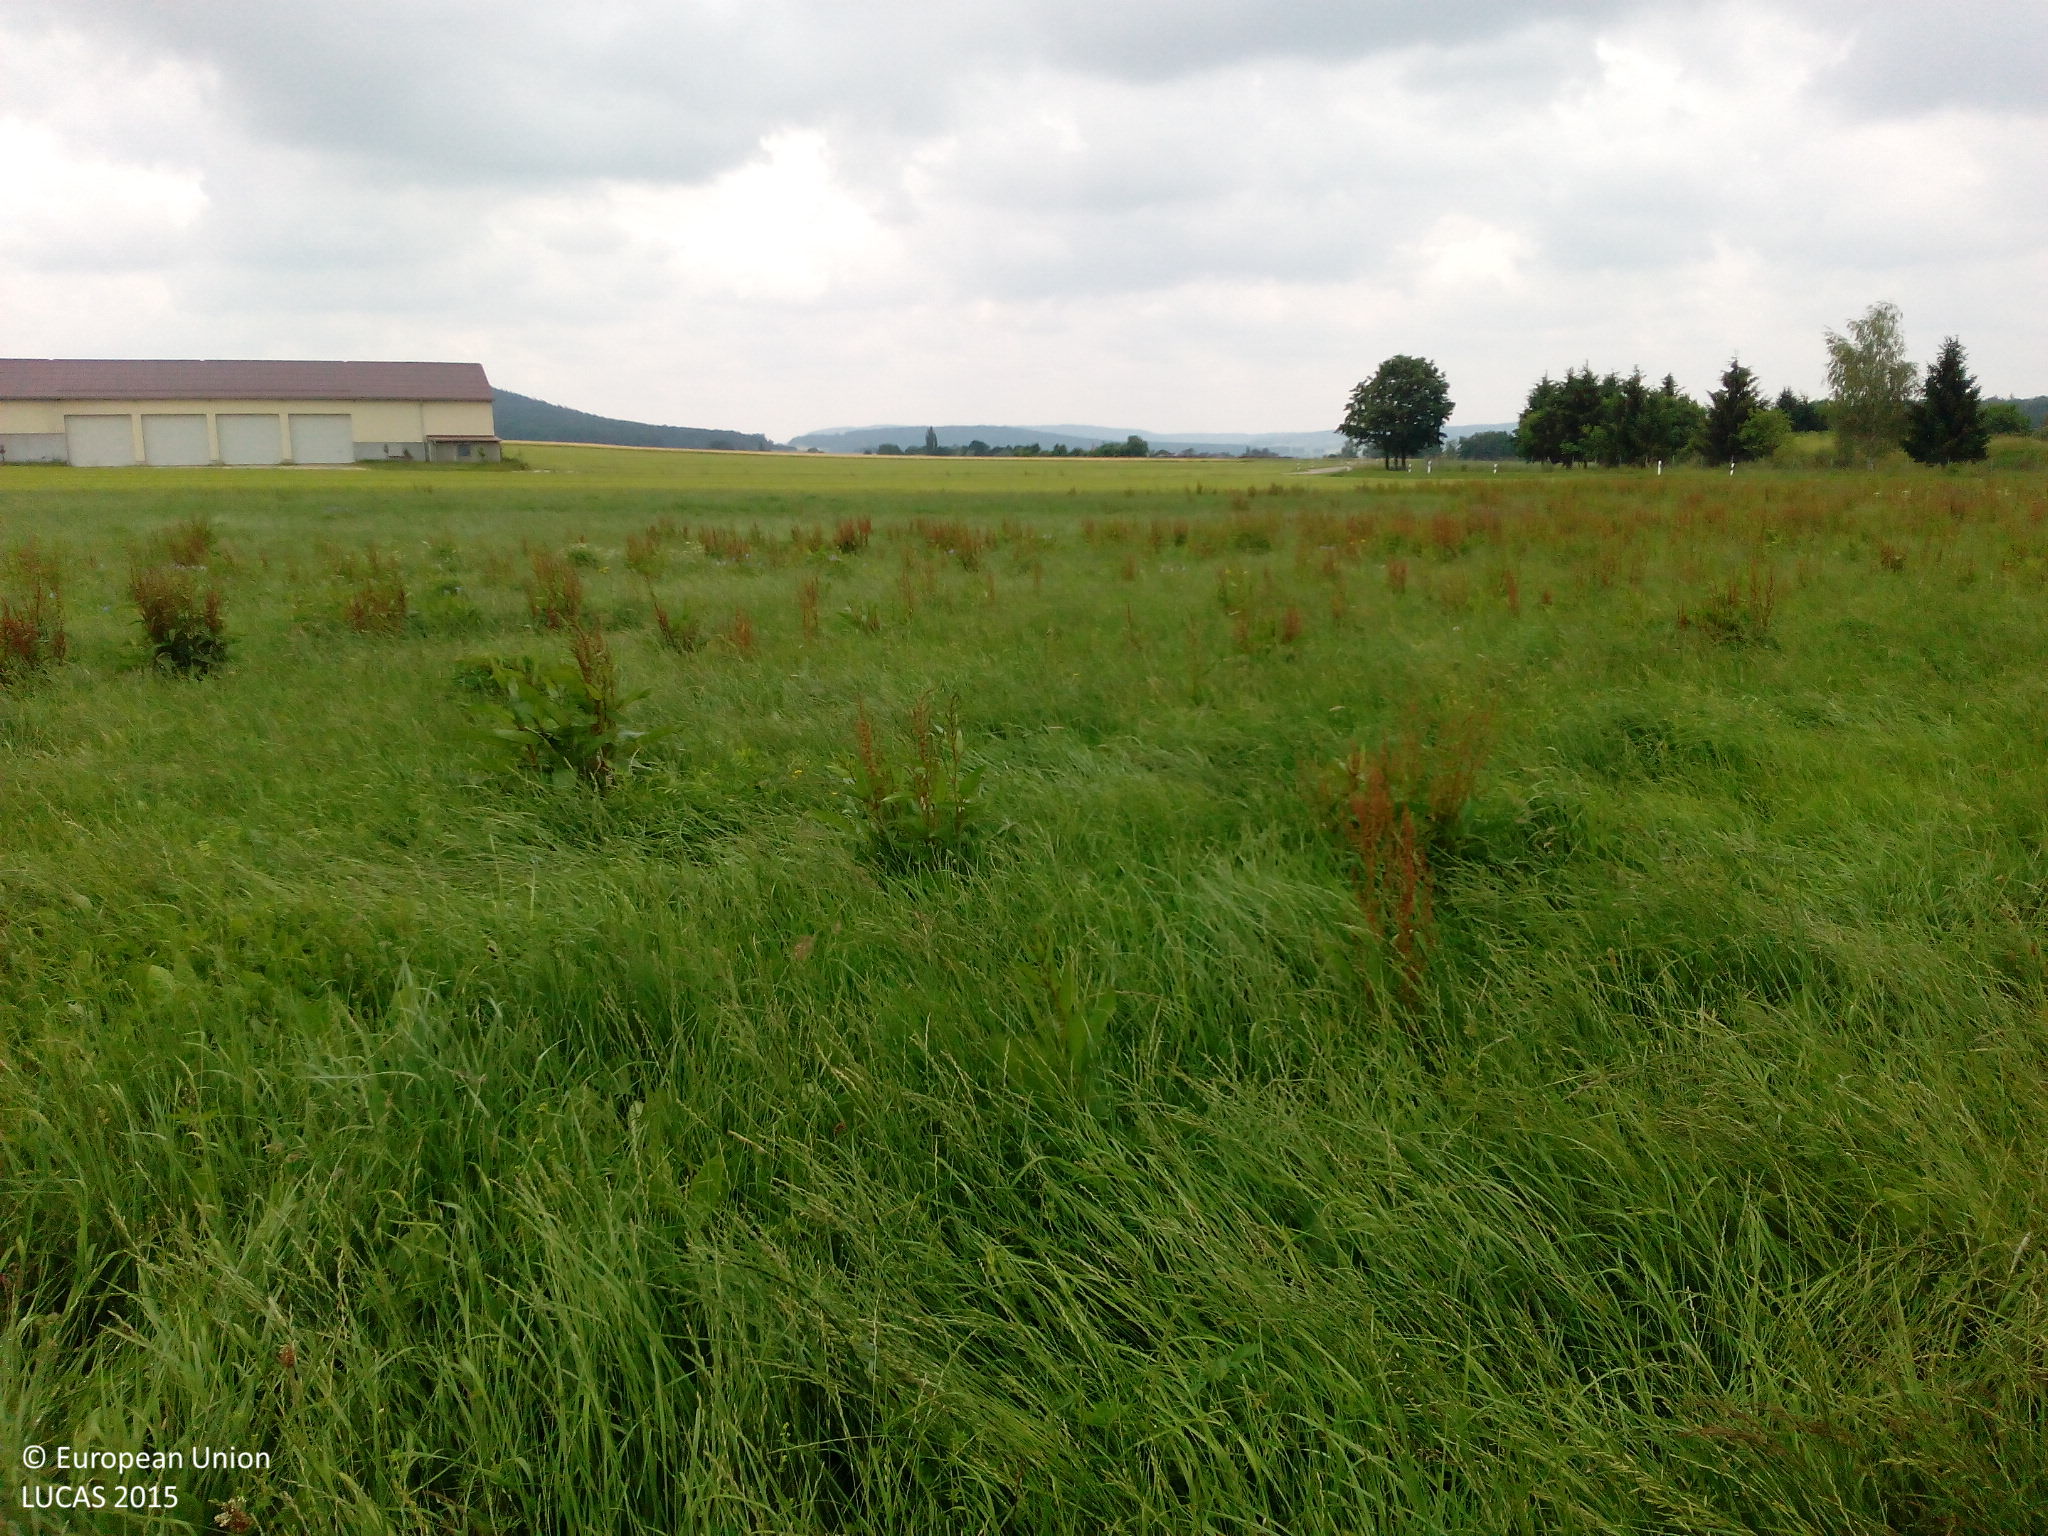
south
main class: Grassland
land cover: Grassland without tree/shrub cover
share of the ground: > 75 %
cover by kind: herbaceous plants 90 %, unconsolidated bare surface 10 %
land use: Agriculture (excluding fallow land and kitchen gardens)
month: June
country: DE
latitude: 49.0656
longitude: 10.8893
